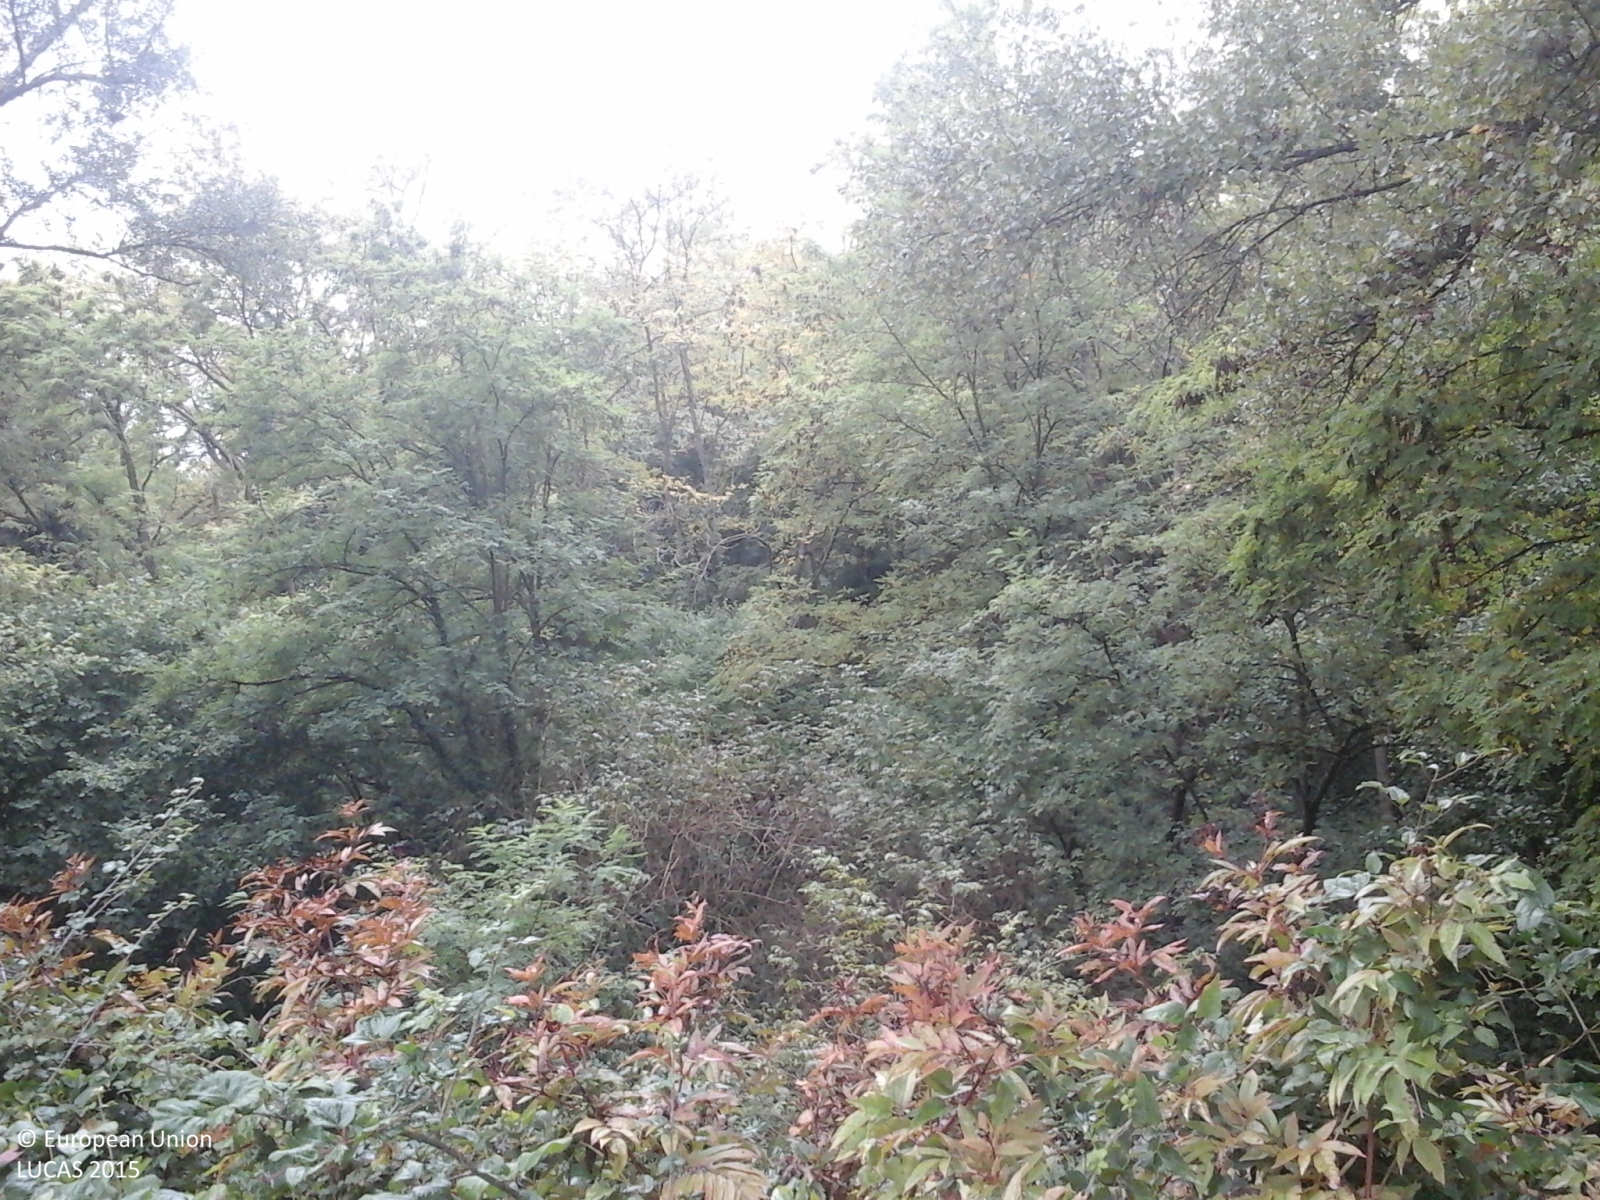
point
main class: Woodland
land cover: Broadleaved woodland
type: floodplain forest
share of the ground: > 75 %
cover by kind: broadleaved forest trees 90 %, shrubs 10 %
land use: Forestry
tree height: > 5 m
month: October
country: IT
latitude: 43.3498
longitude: 12.3253
